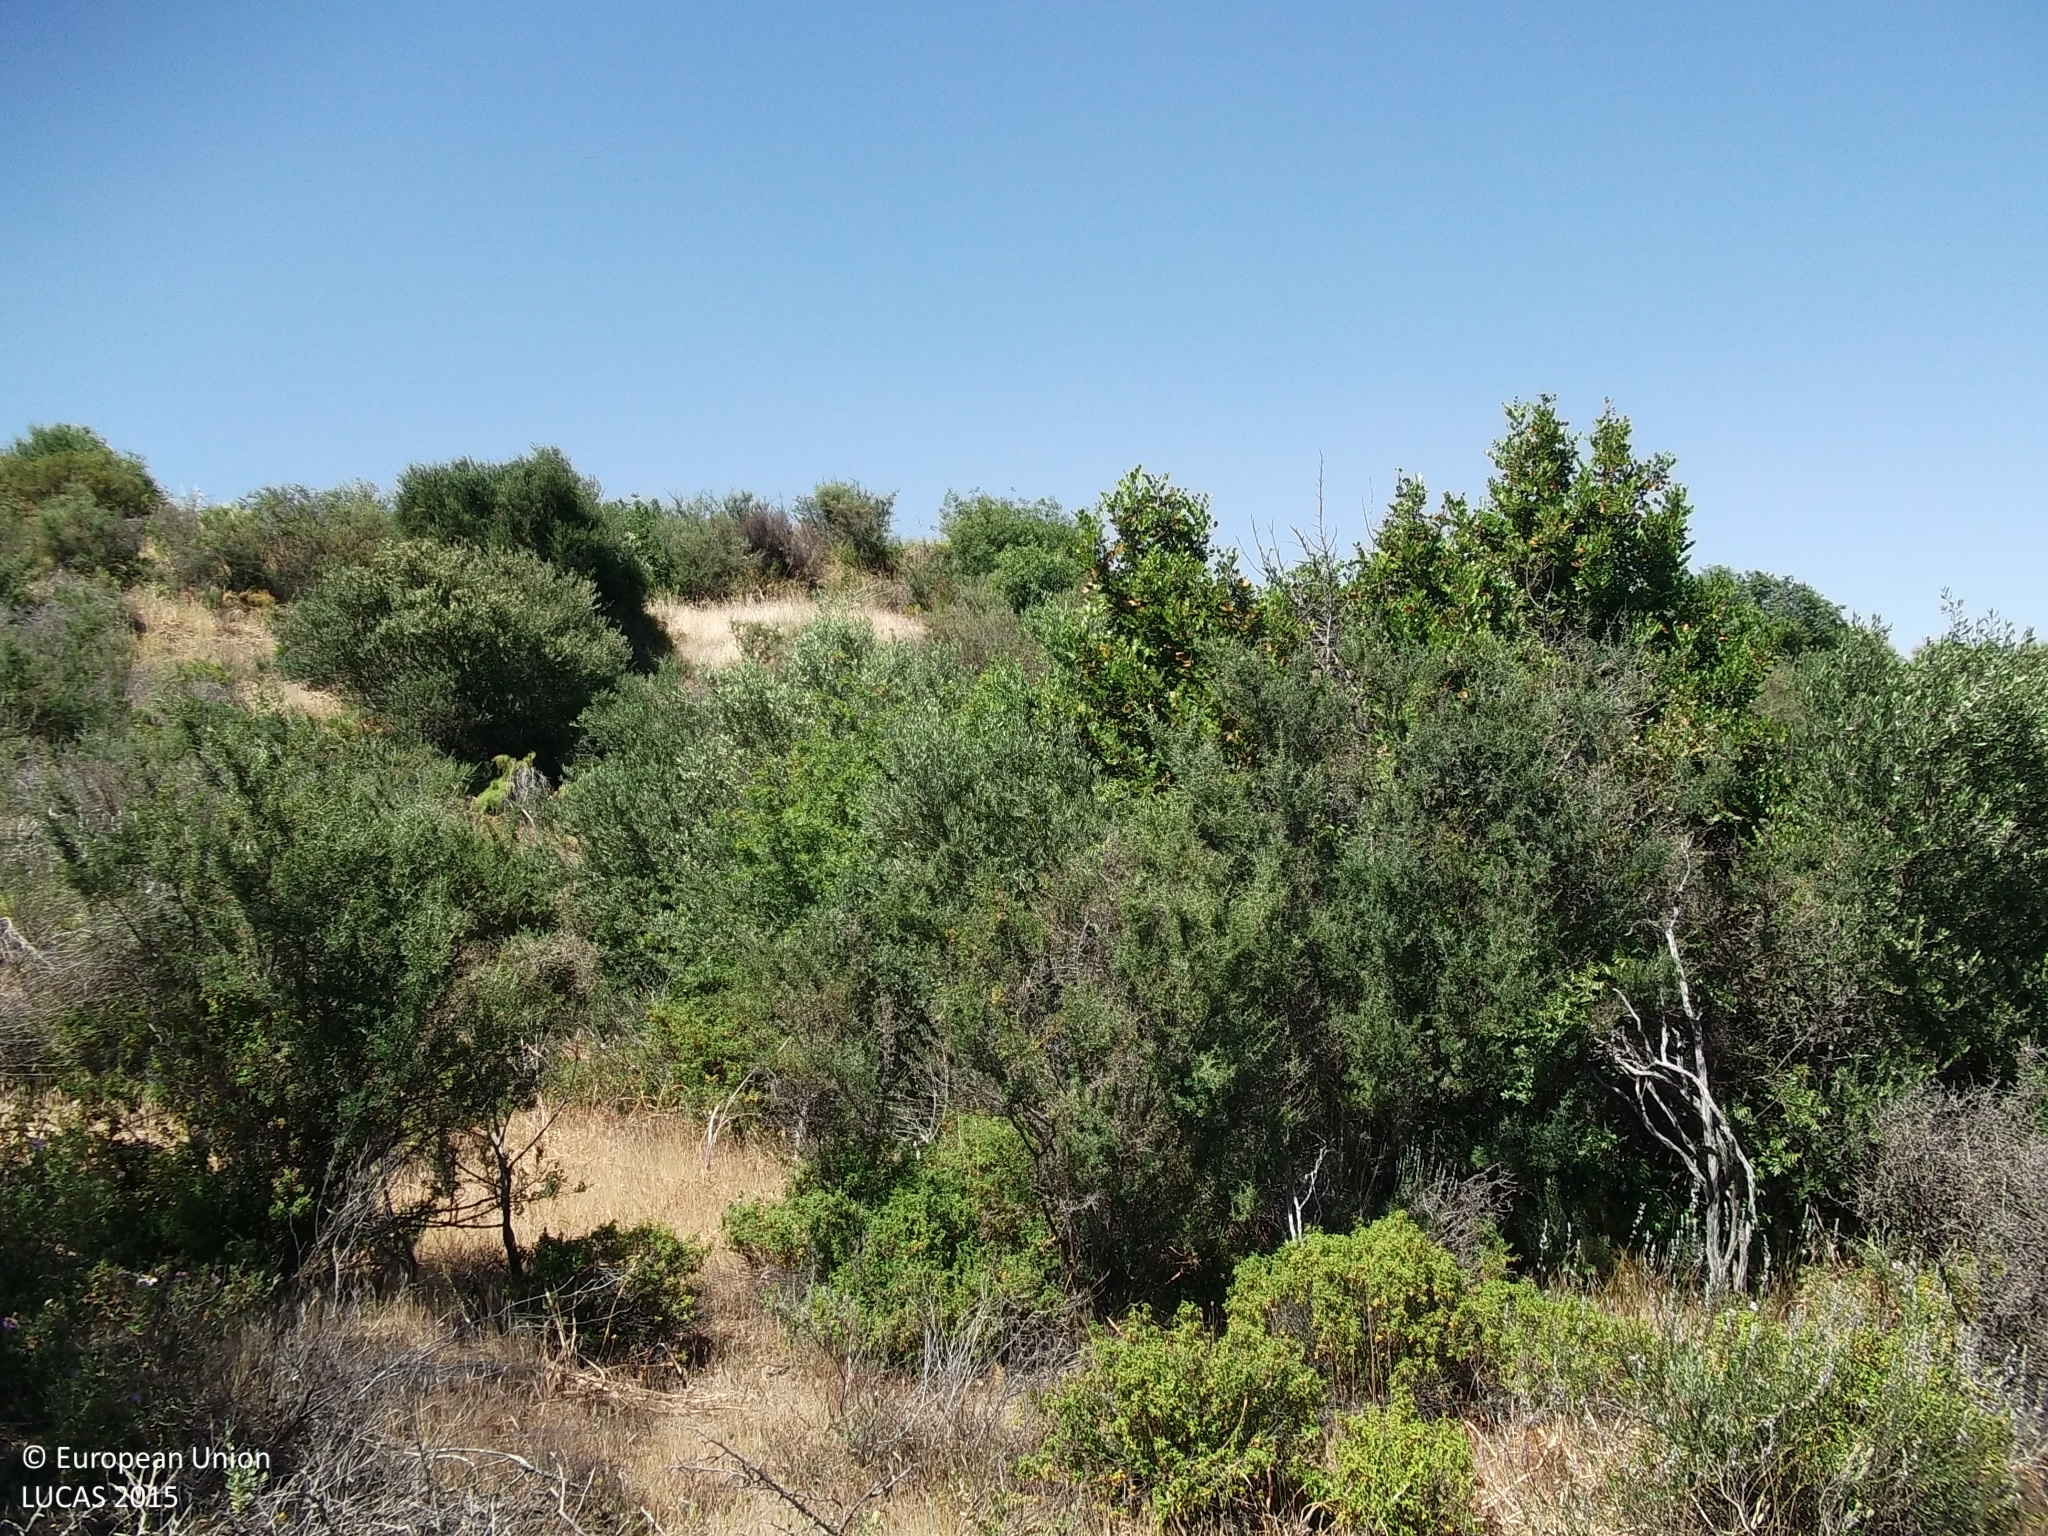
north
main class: Shrubland
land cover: Shrubland with sparse tree cover
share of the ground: 50 - 75 %
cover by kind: shrubs 65 %, herbaceous plants 15 %, unconsolidated bare surface 15 %, broadleaved forest trees 5 %
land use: Semi-natural and natural areas not in use
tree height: > 5 m
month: May
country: CY
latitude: 34.8798
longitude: 33.3223
